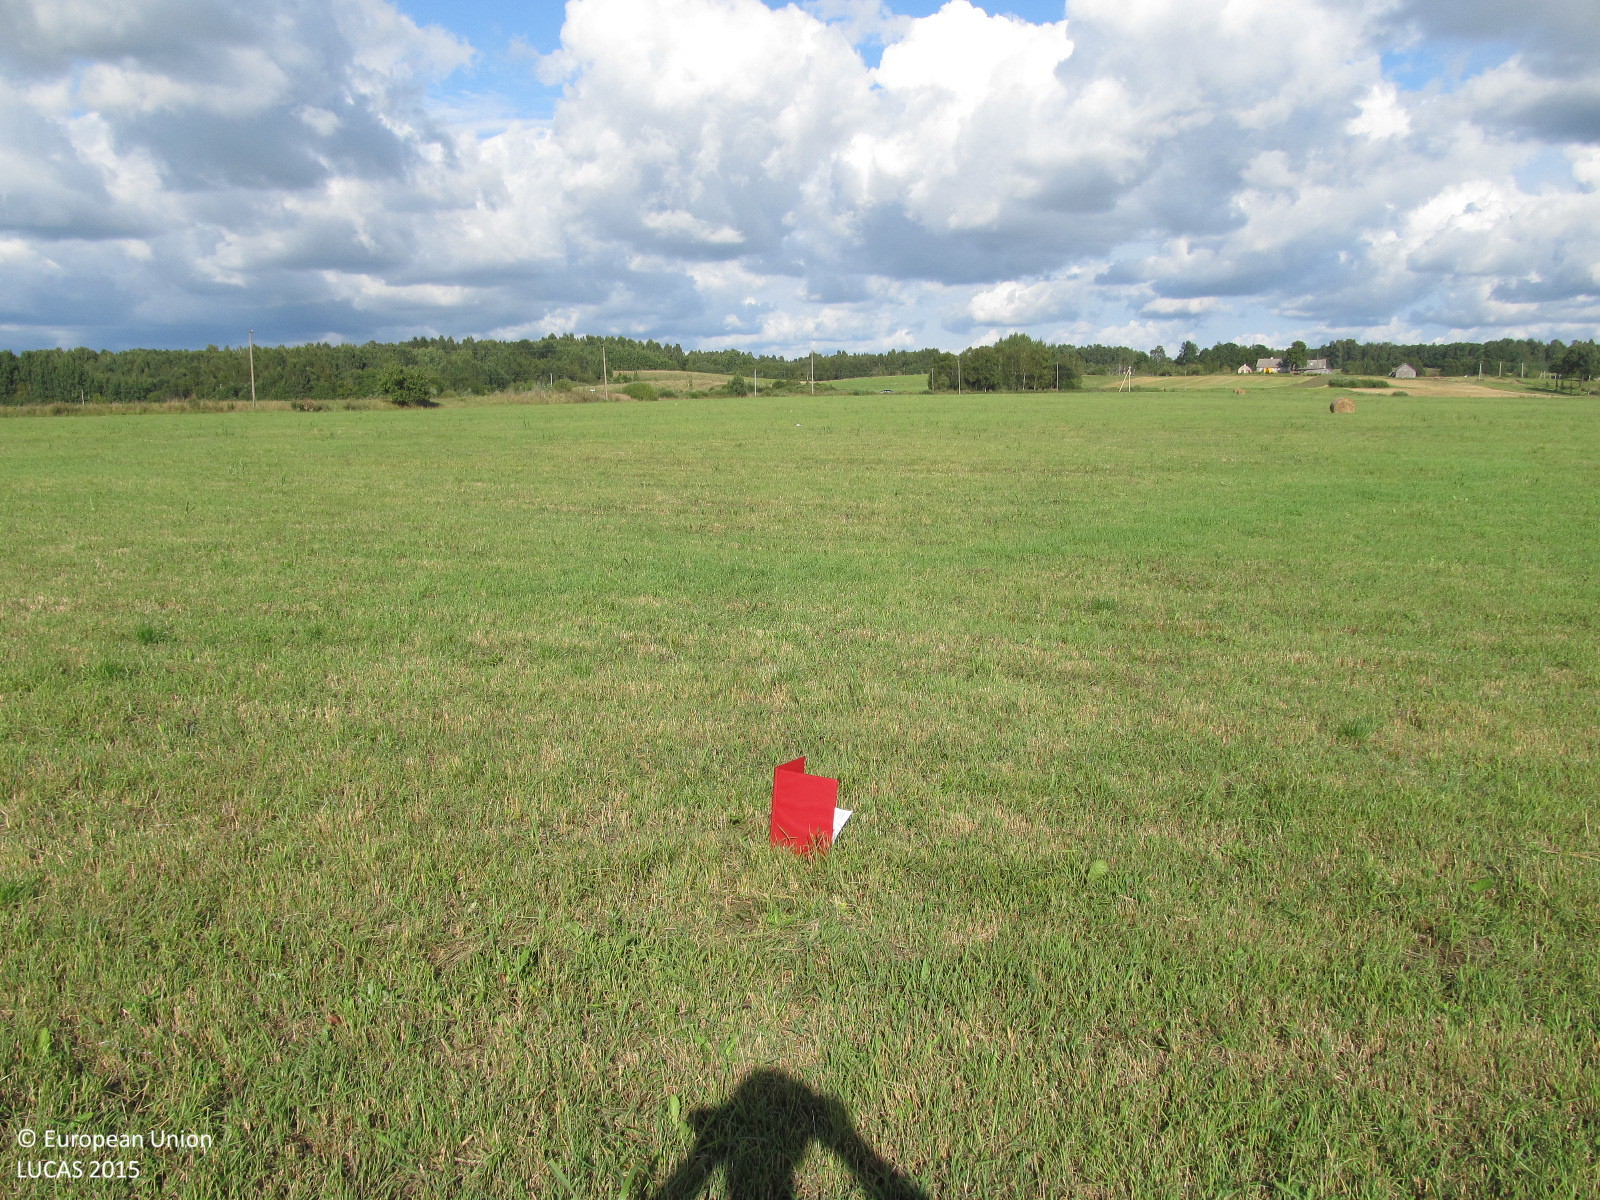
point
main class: Grassland
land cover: Grassland without tree/shrub cover
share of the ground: > 75 %
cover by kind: herbaceous plants 100 %
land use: Agriculture (excluding fallow land and kitchen gardens)
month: September
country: LT
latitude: 55.6690
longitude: 22.6388
